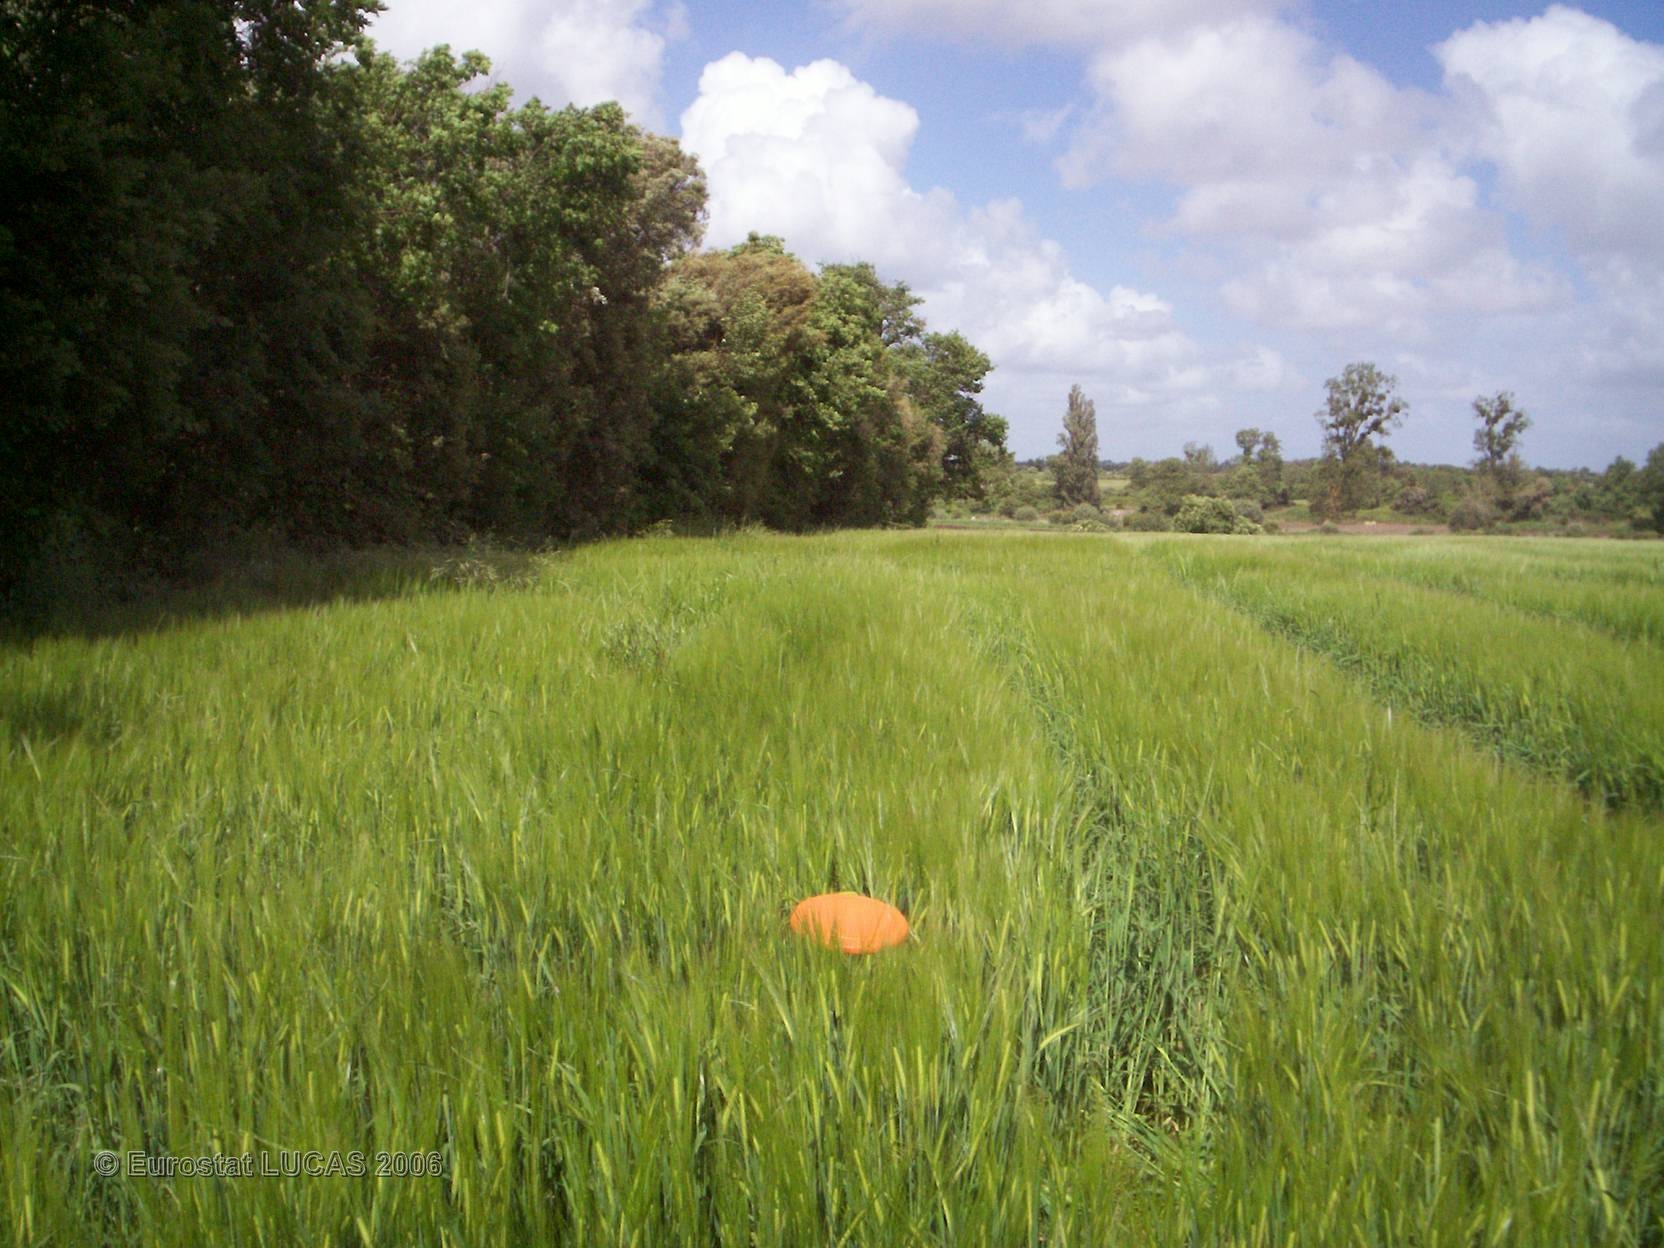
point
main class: Cropland
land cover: Barley
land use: Agriculture (excluding fallow land and kitchen gardens)
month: May
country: FR
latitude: 45.7497
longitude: -0.7850
